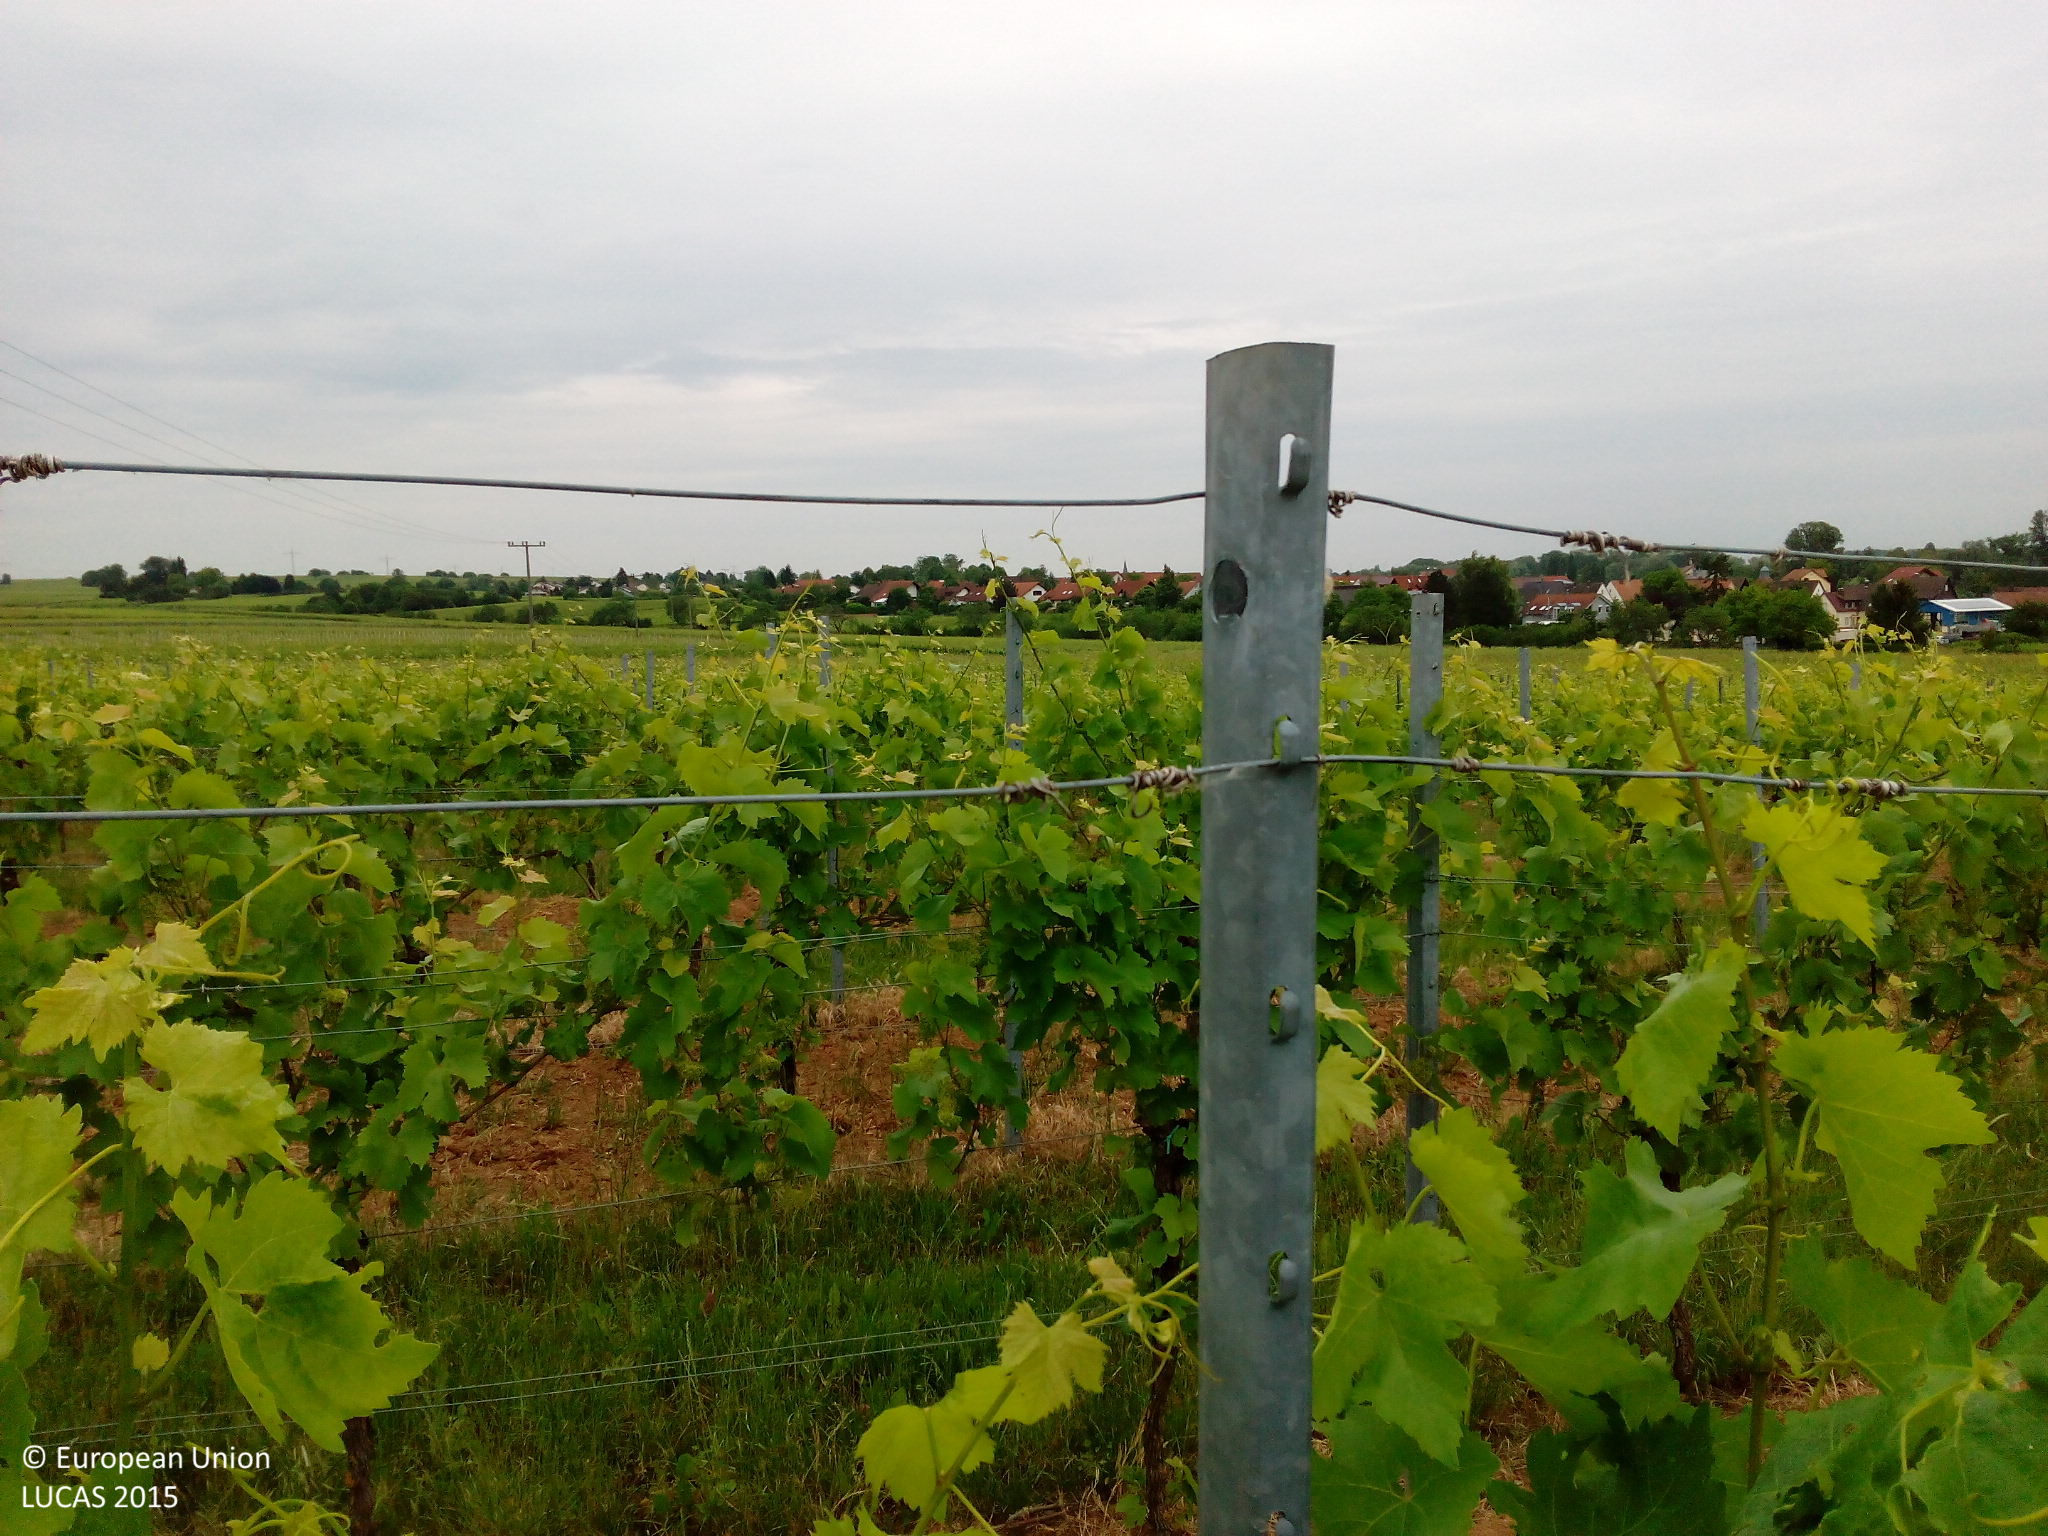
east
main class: Cropland
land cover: Vineyards
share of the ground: 10 - 25 %
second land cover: Grassland without tree/shrub cover
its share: 25 - 50 %
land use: Agriculture (excluding fallow land and kitchen gardens)
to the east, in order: Vineyards; Grassland without tree/shrub cover; Paved roads, cycling and walking lanes; Grass margins; Vineyards
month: June
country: DE
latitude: 49.2144
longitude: 8.0649
